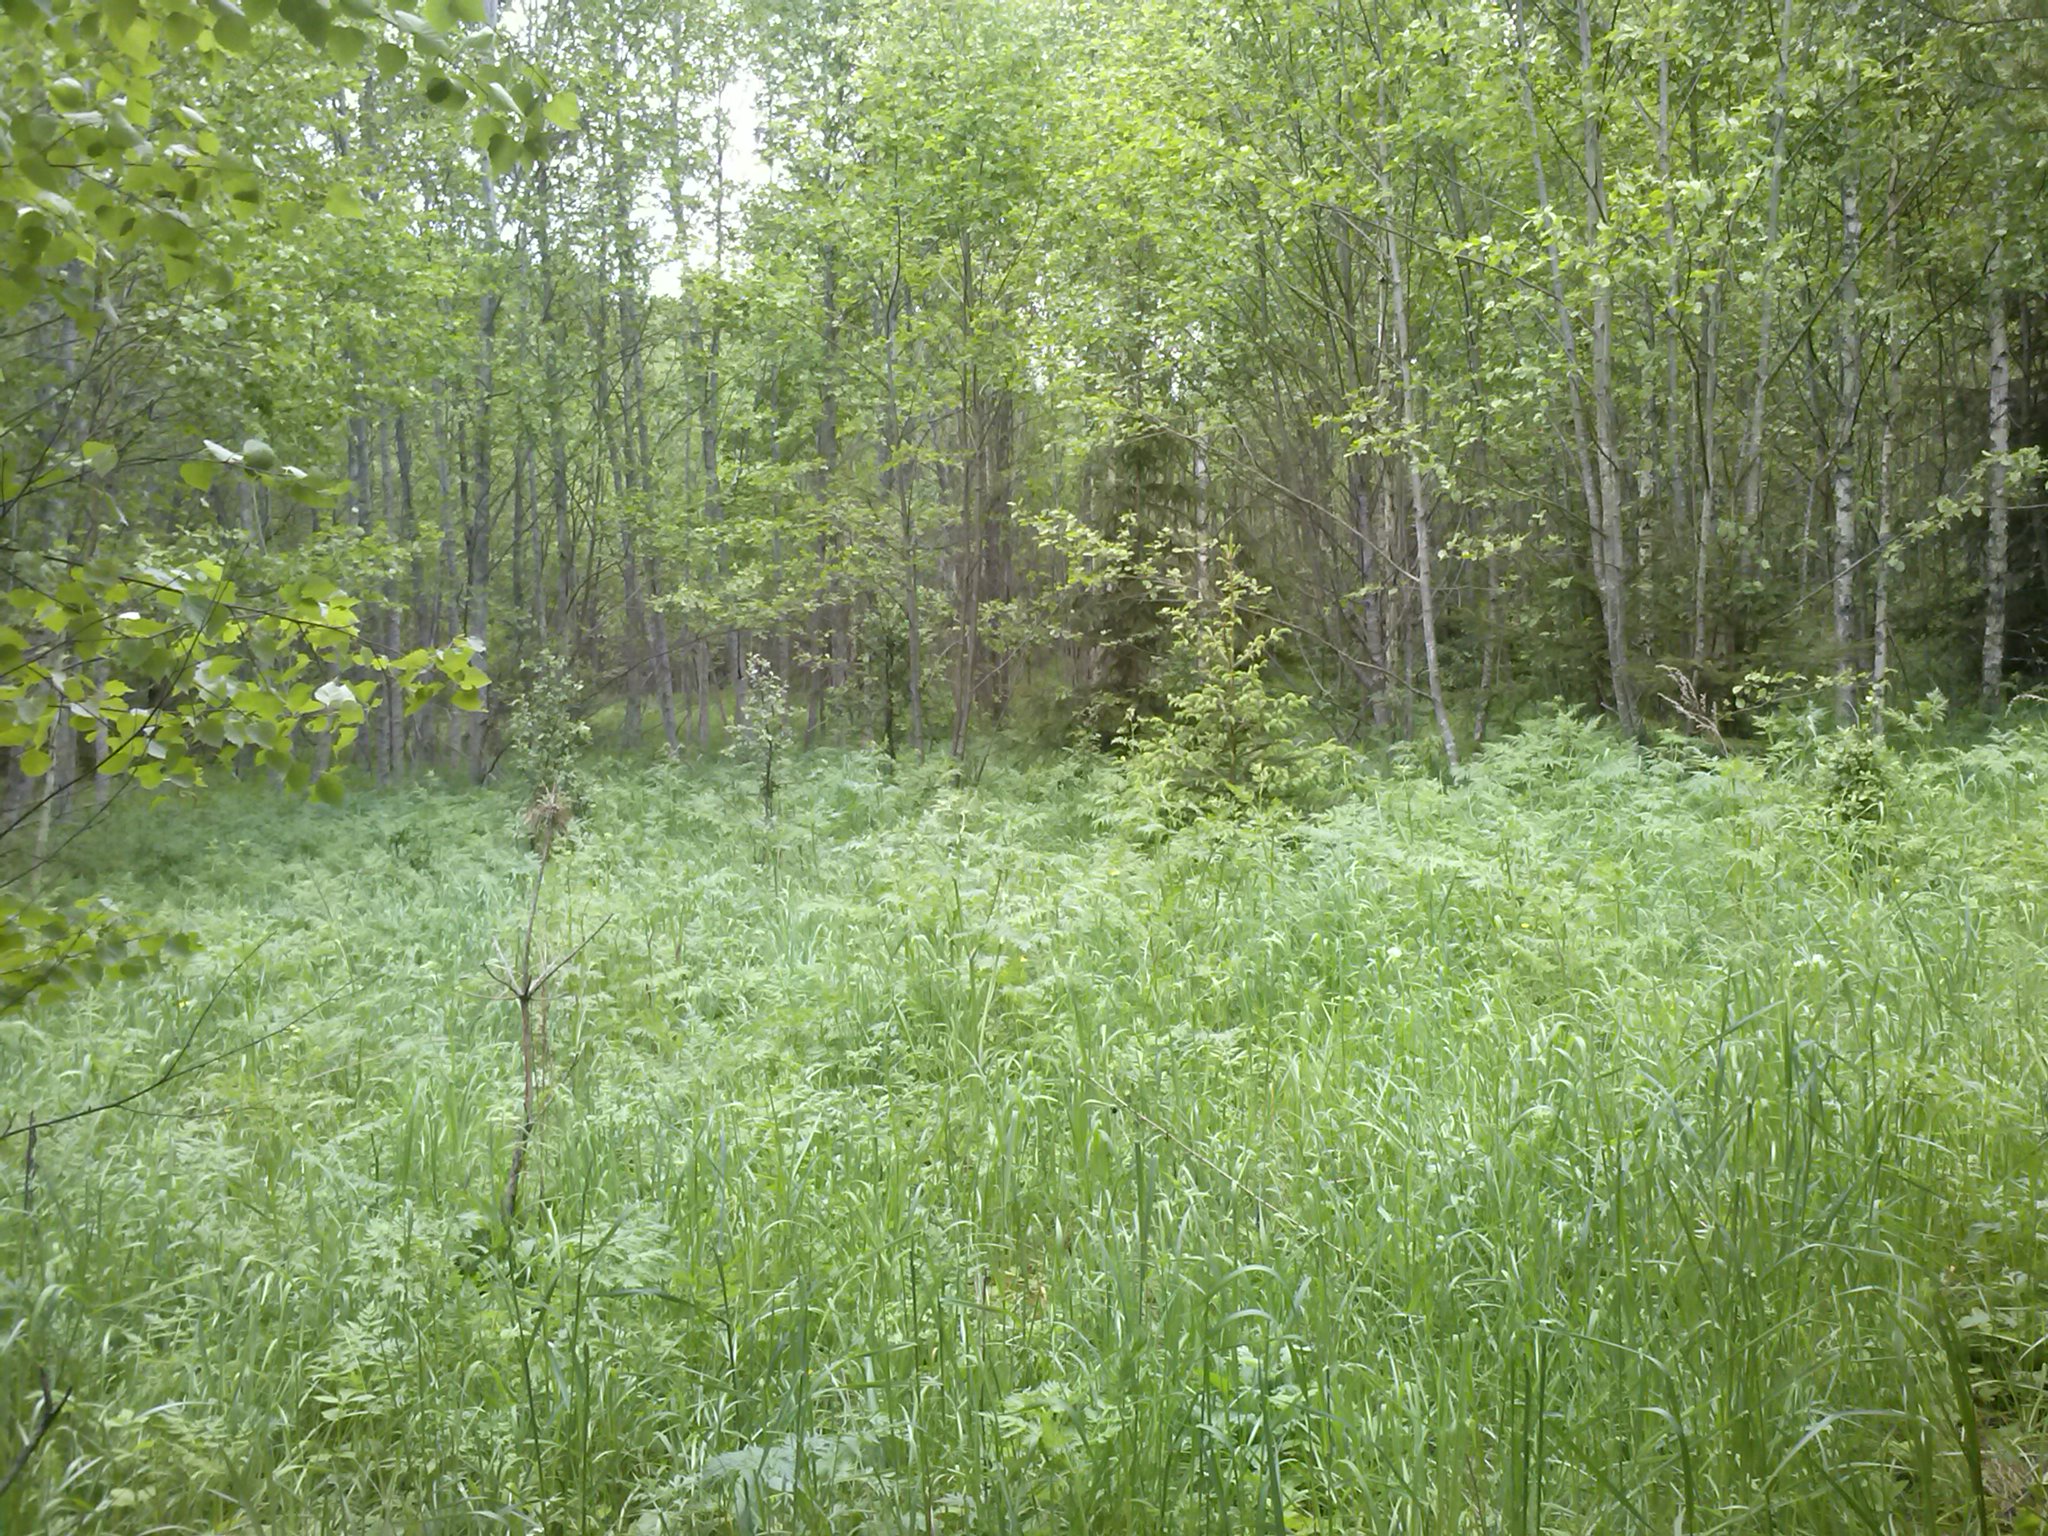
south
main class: Woodland
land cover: Other mixed woodland
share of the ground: > 75 %
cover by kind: coniferous forest trees 45 %, broadleaved forest trees 30 %, herbaceous plants 25 %
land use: Forestry
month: May
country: LV
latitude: 56.1923
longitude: 27.7380
